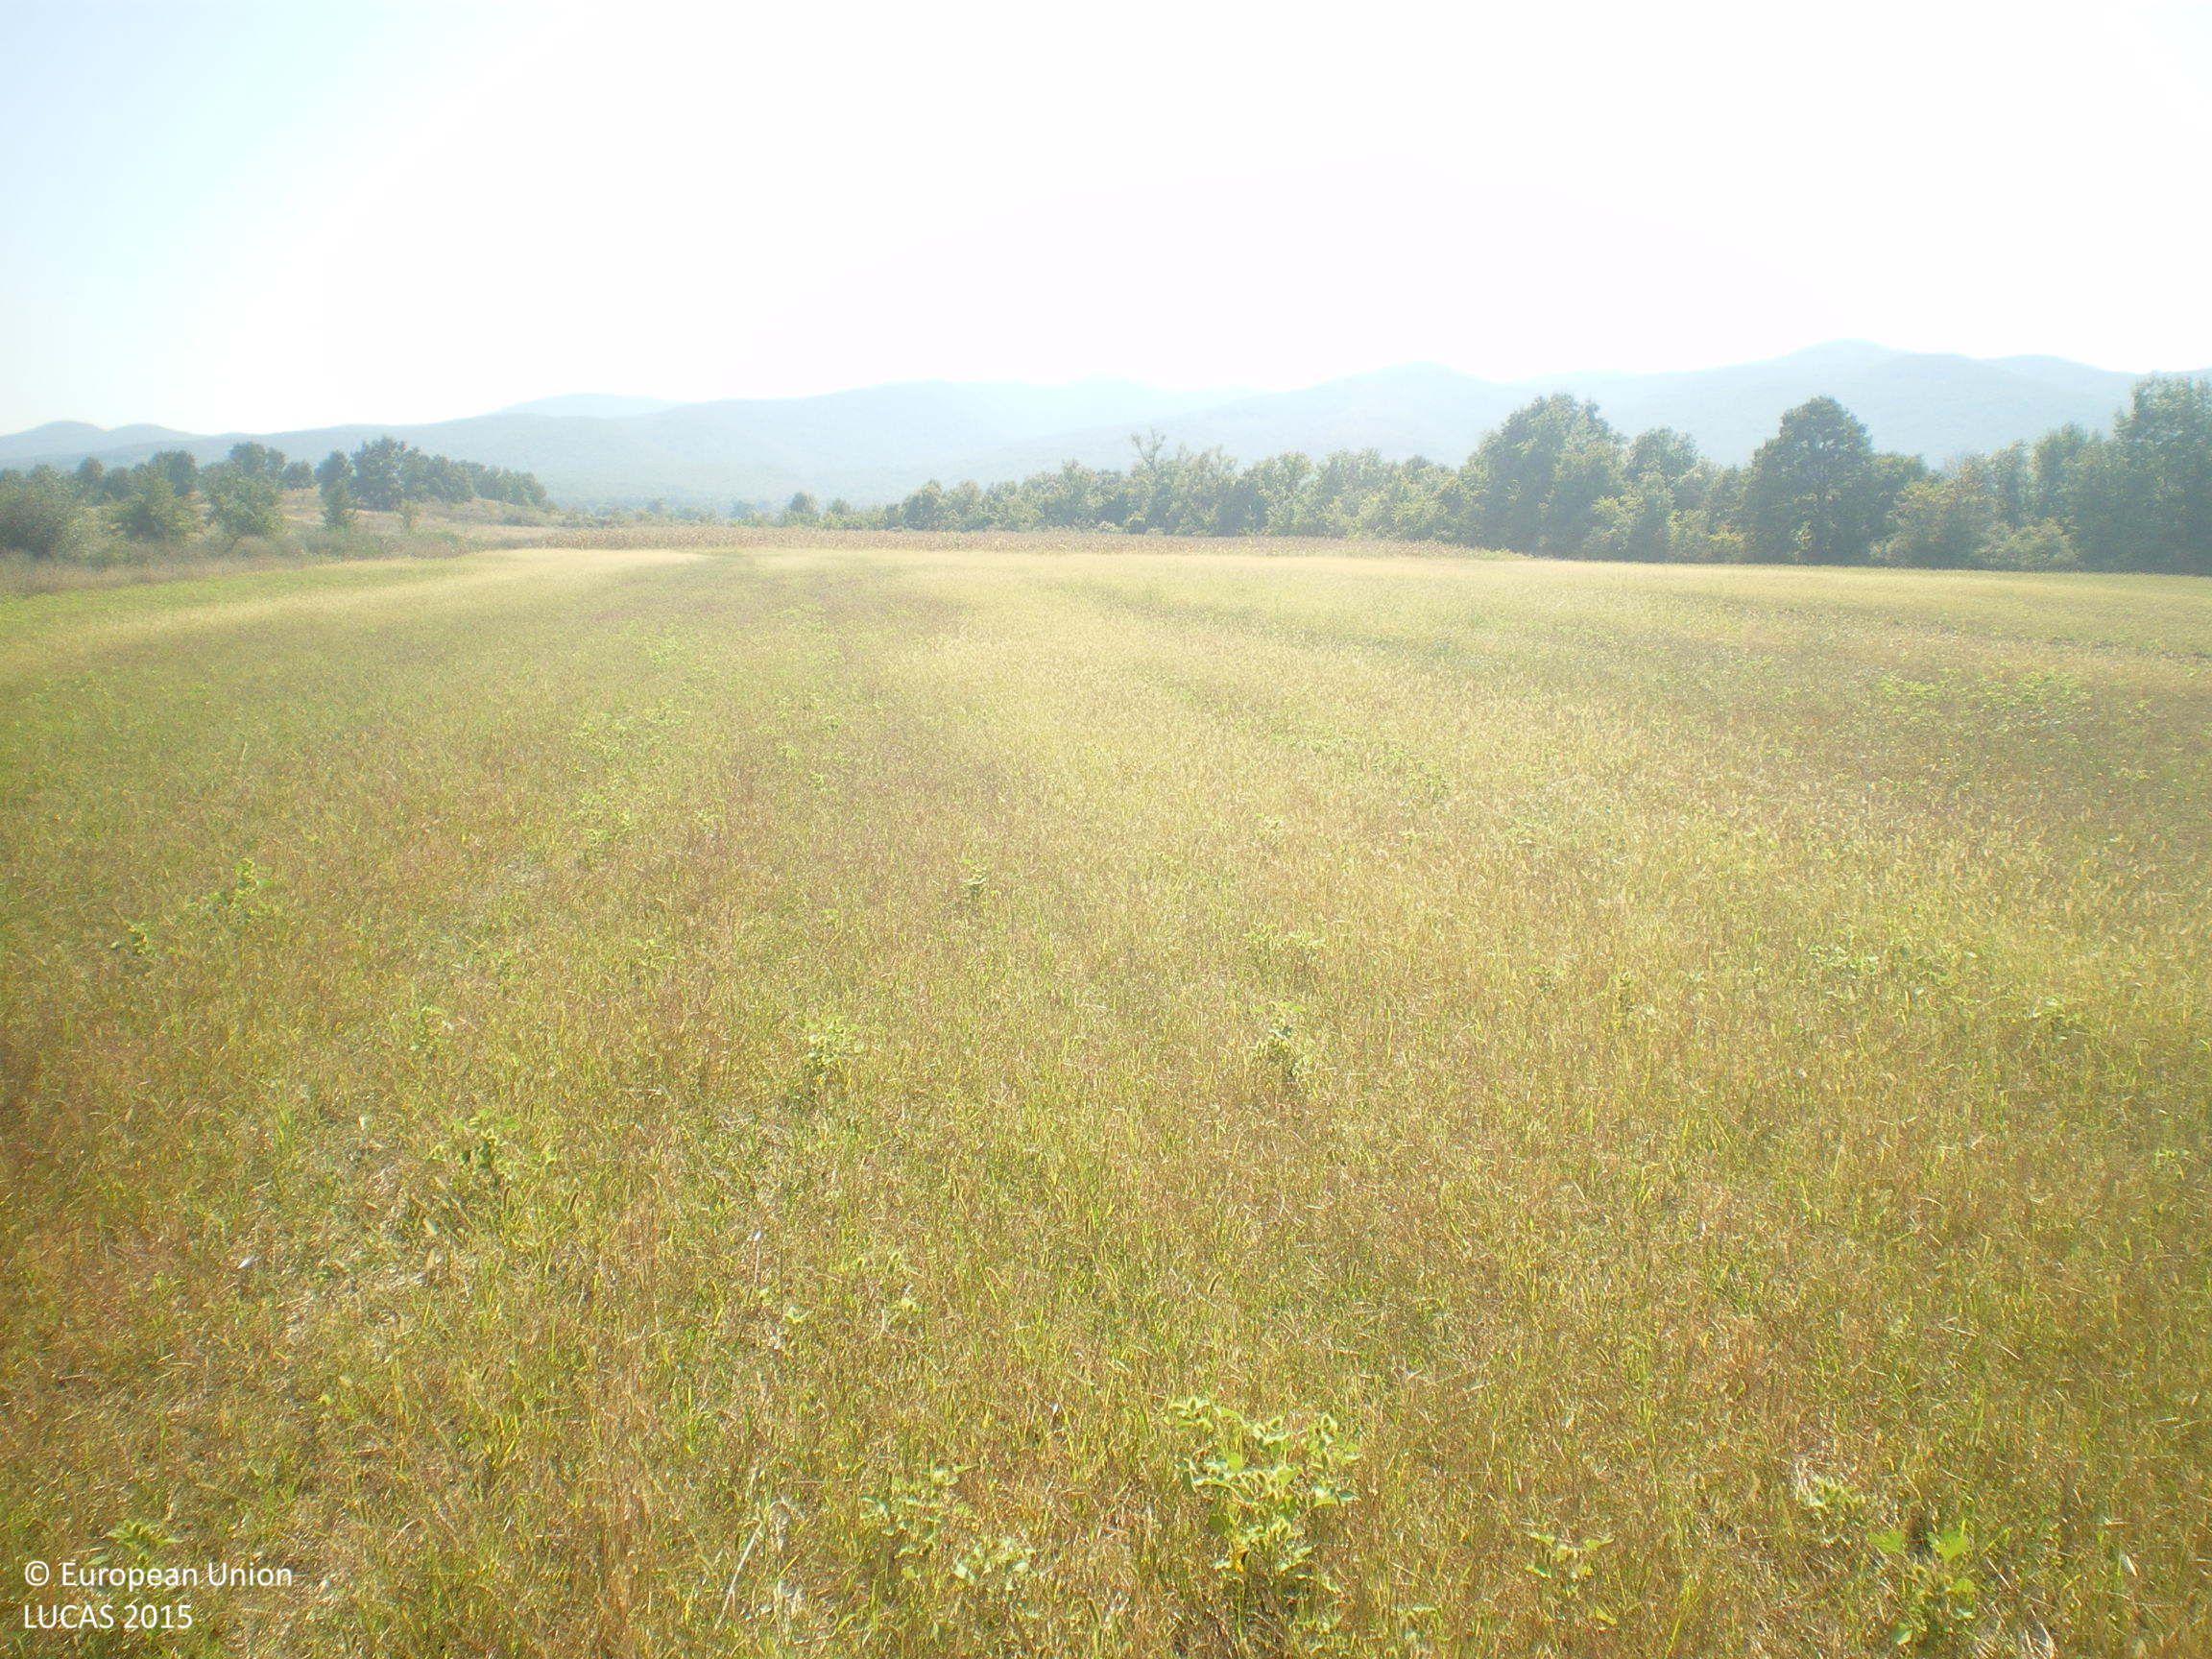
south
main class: Cropland
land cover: Common wheat
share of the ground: < 10 %
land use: Agriculture (excluding fallow land and kitchen gardens)
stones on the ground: < 10 %
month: September
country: BG
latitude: 41.7710
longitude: 26.0357
